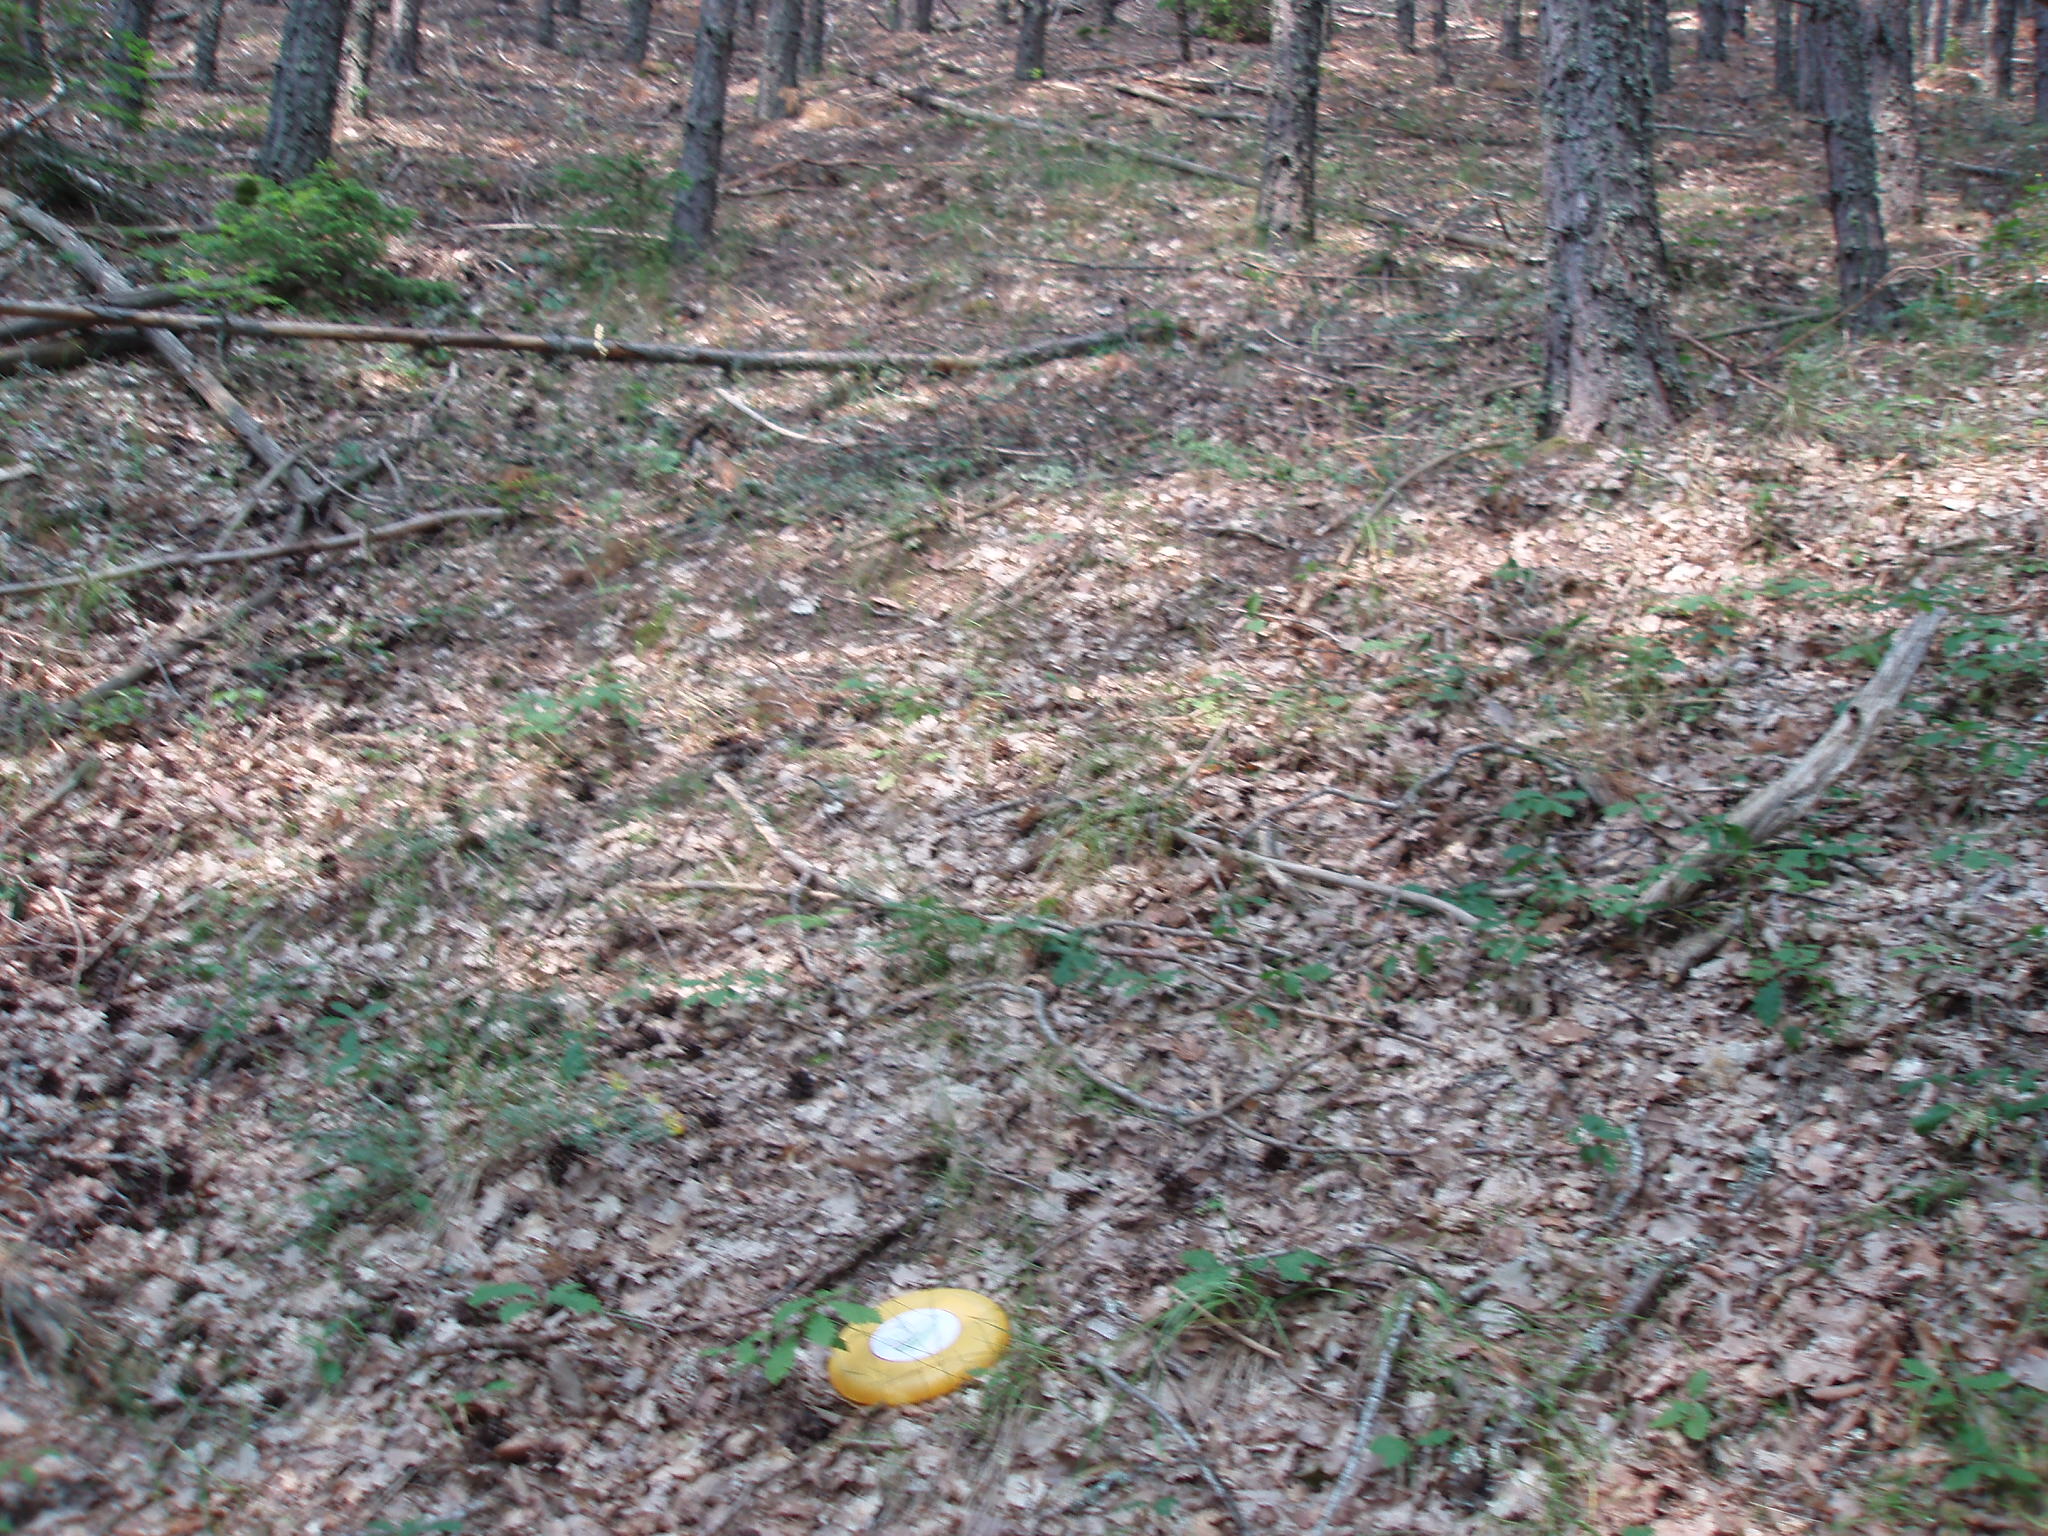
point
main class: Woodland
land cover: Pine dominated mixed woodland
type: hemiboreal forest and nemoral coniferous forest and mixed broadleaved-coniferous forest
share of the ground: > 75 %
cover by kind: coniferous forest trees 75 %, broadleaved forest trees 25 %
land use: Forestry
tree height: > 5 m
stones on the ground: > 50 %
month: July
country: BG
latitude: 42.0478
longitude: 23.6976
